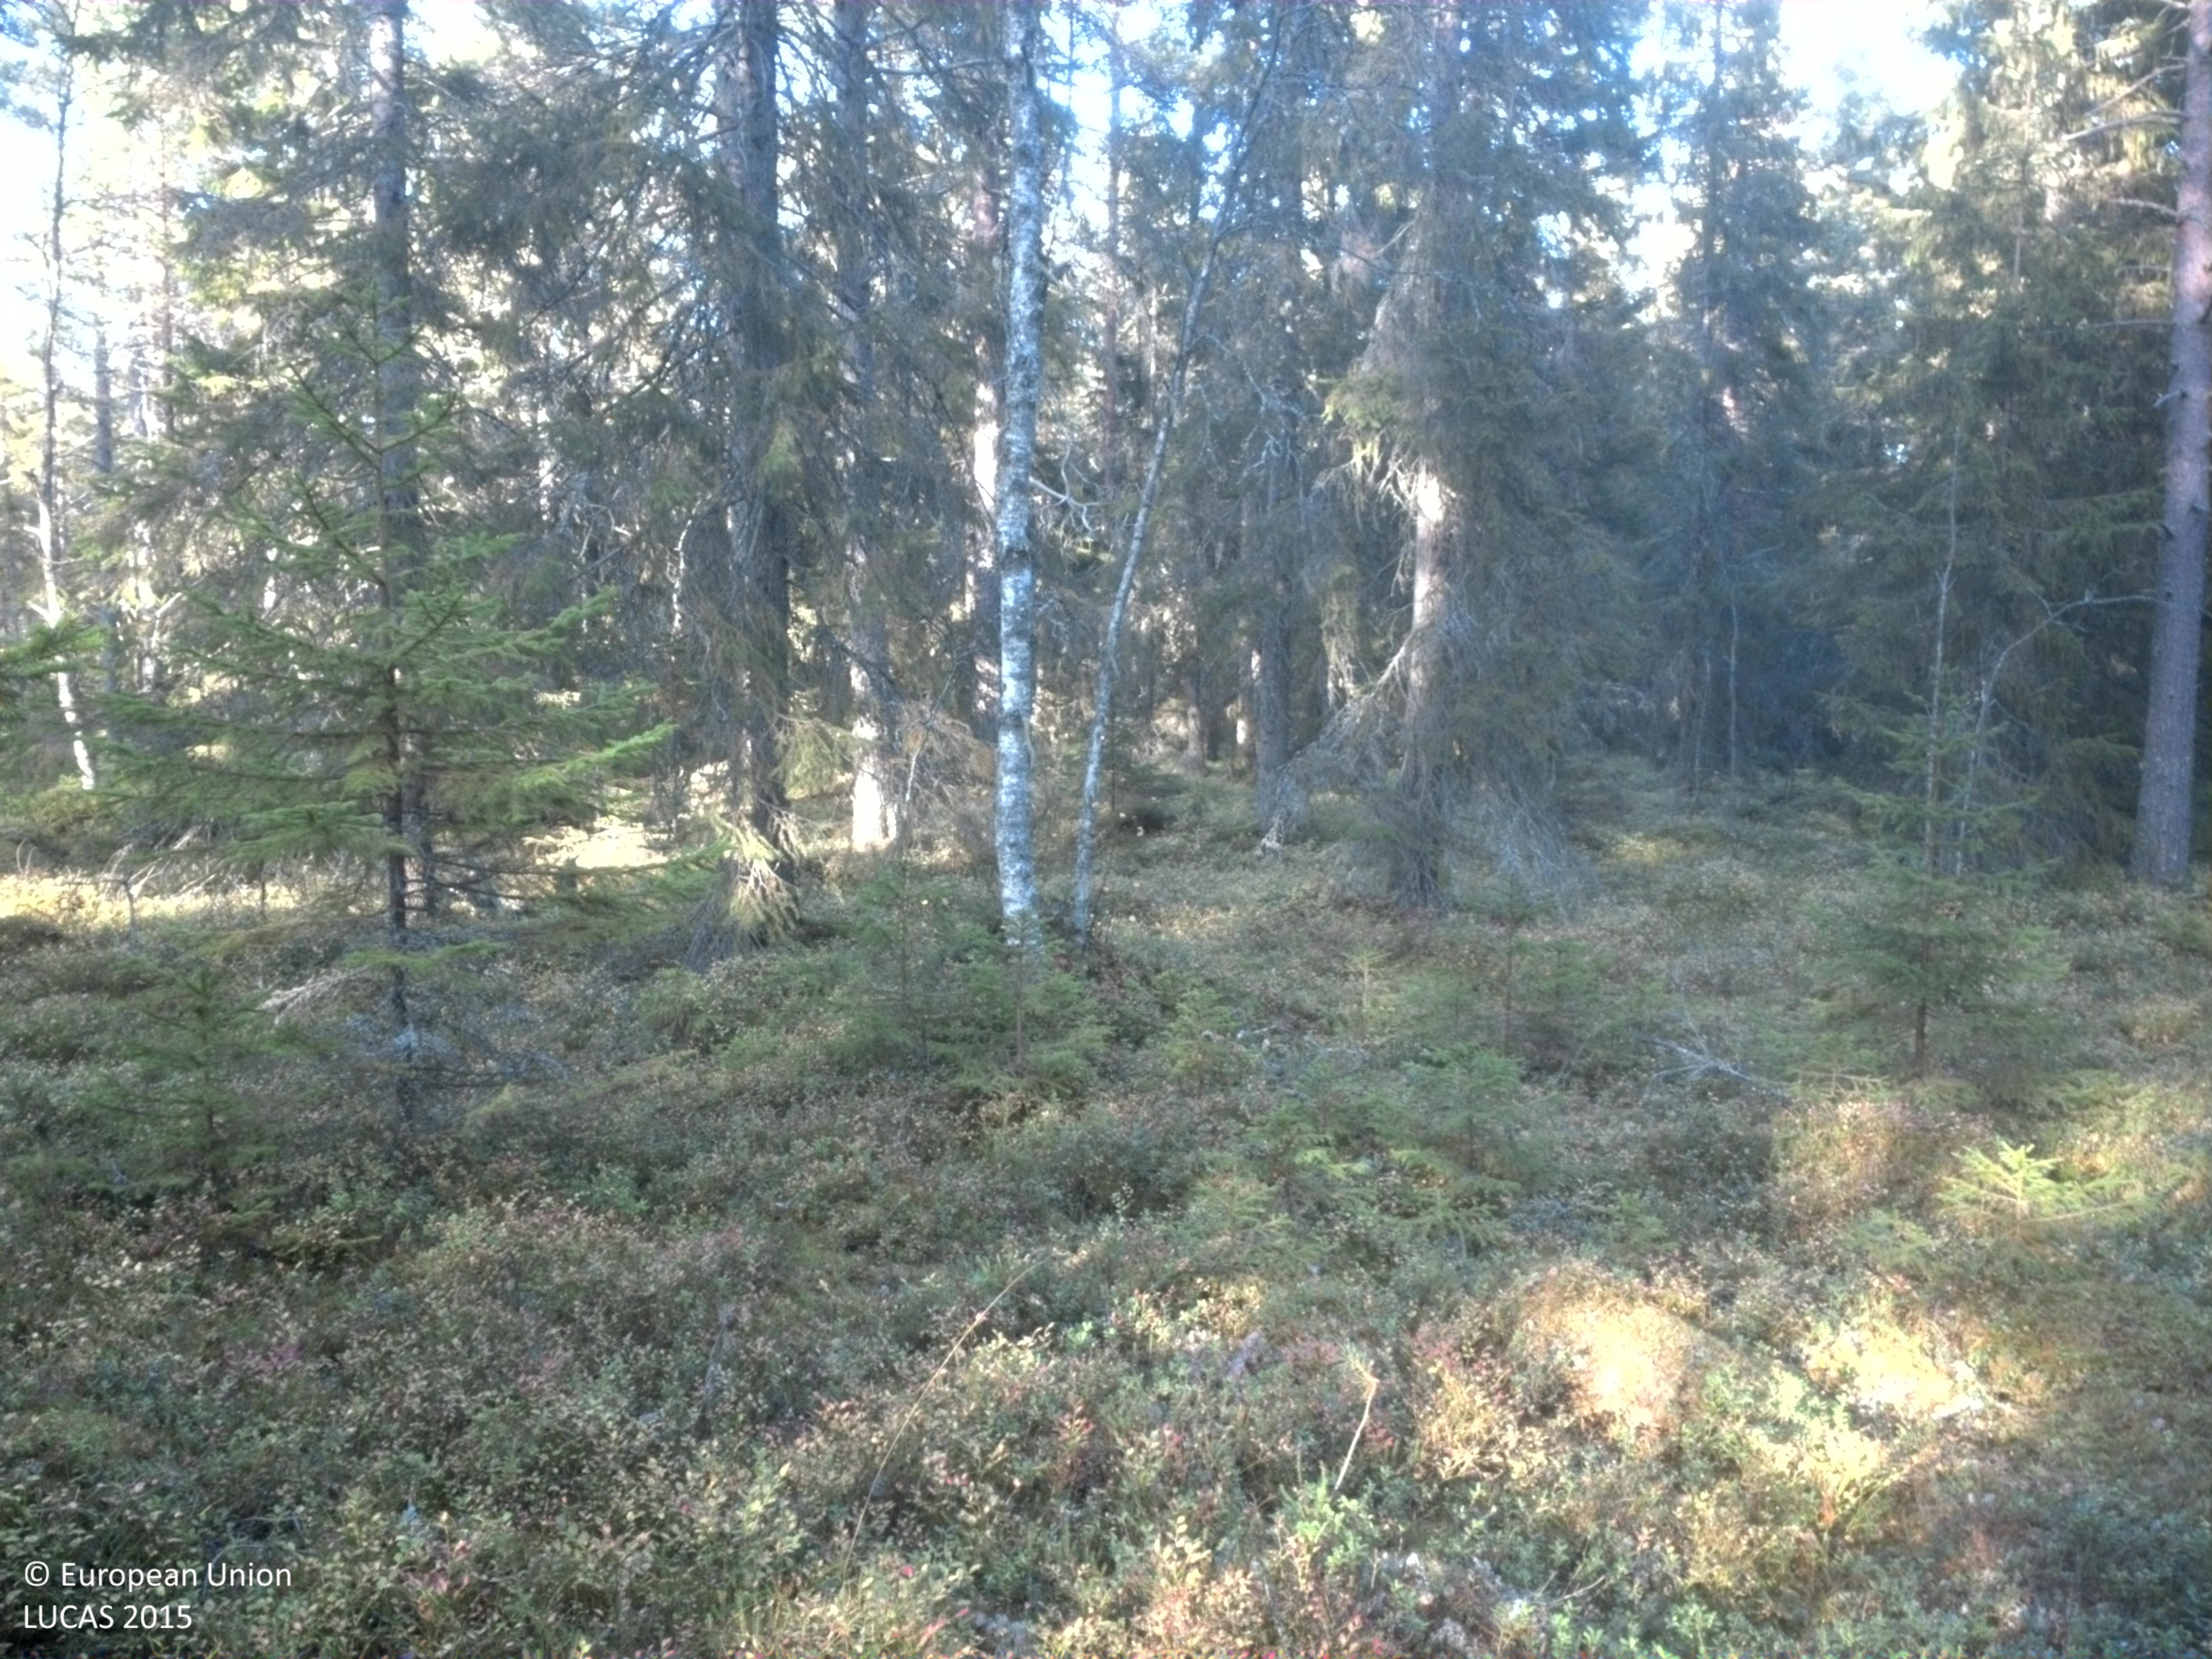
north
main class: Woodland
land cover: Other coniferous woodland
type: boreal forest
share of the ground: 50 - 75 %
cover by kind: coniferous forest trees 65 %, shrubs 30 %, lichens and mosses 5 %
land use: Forestry
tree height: > 5 m
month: October
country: SE
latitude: 63.8707
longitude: 20.7101
